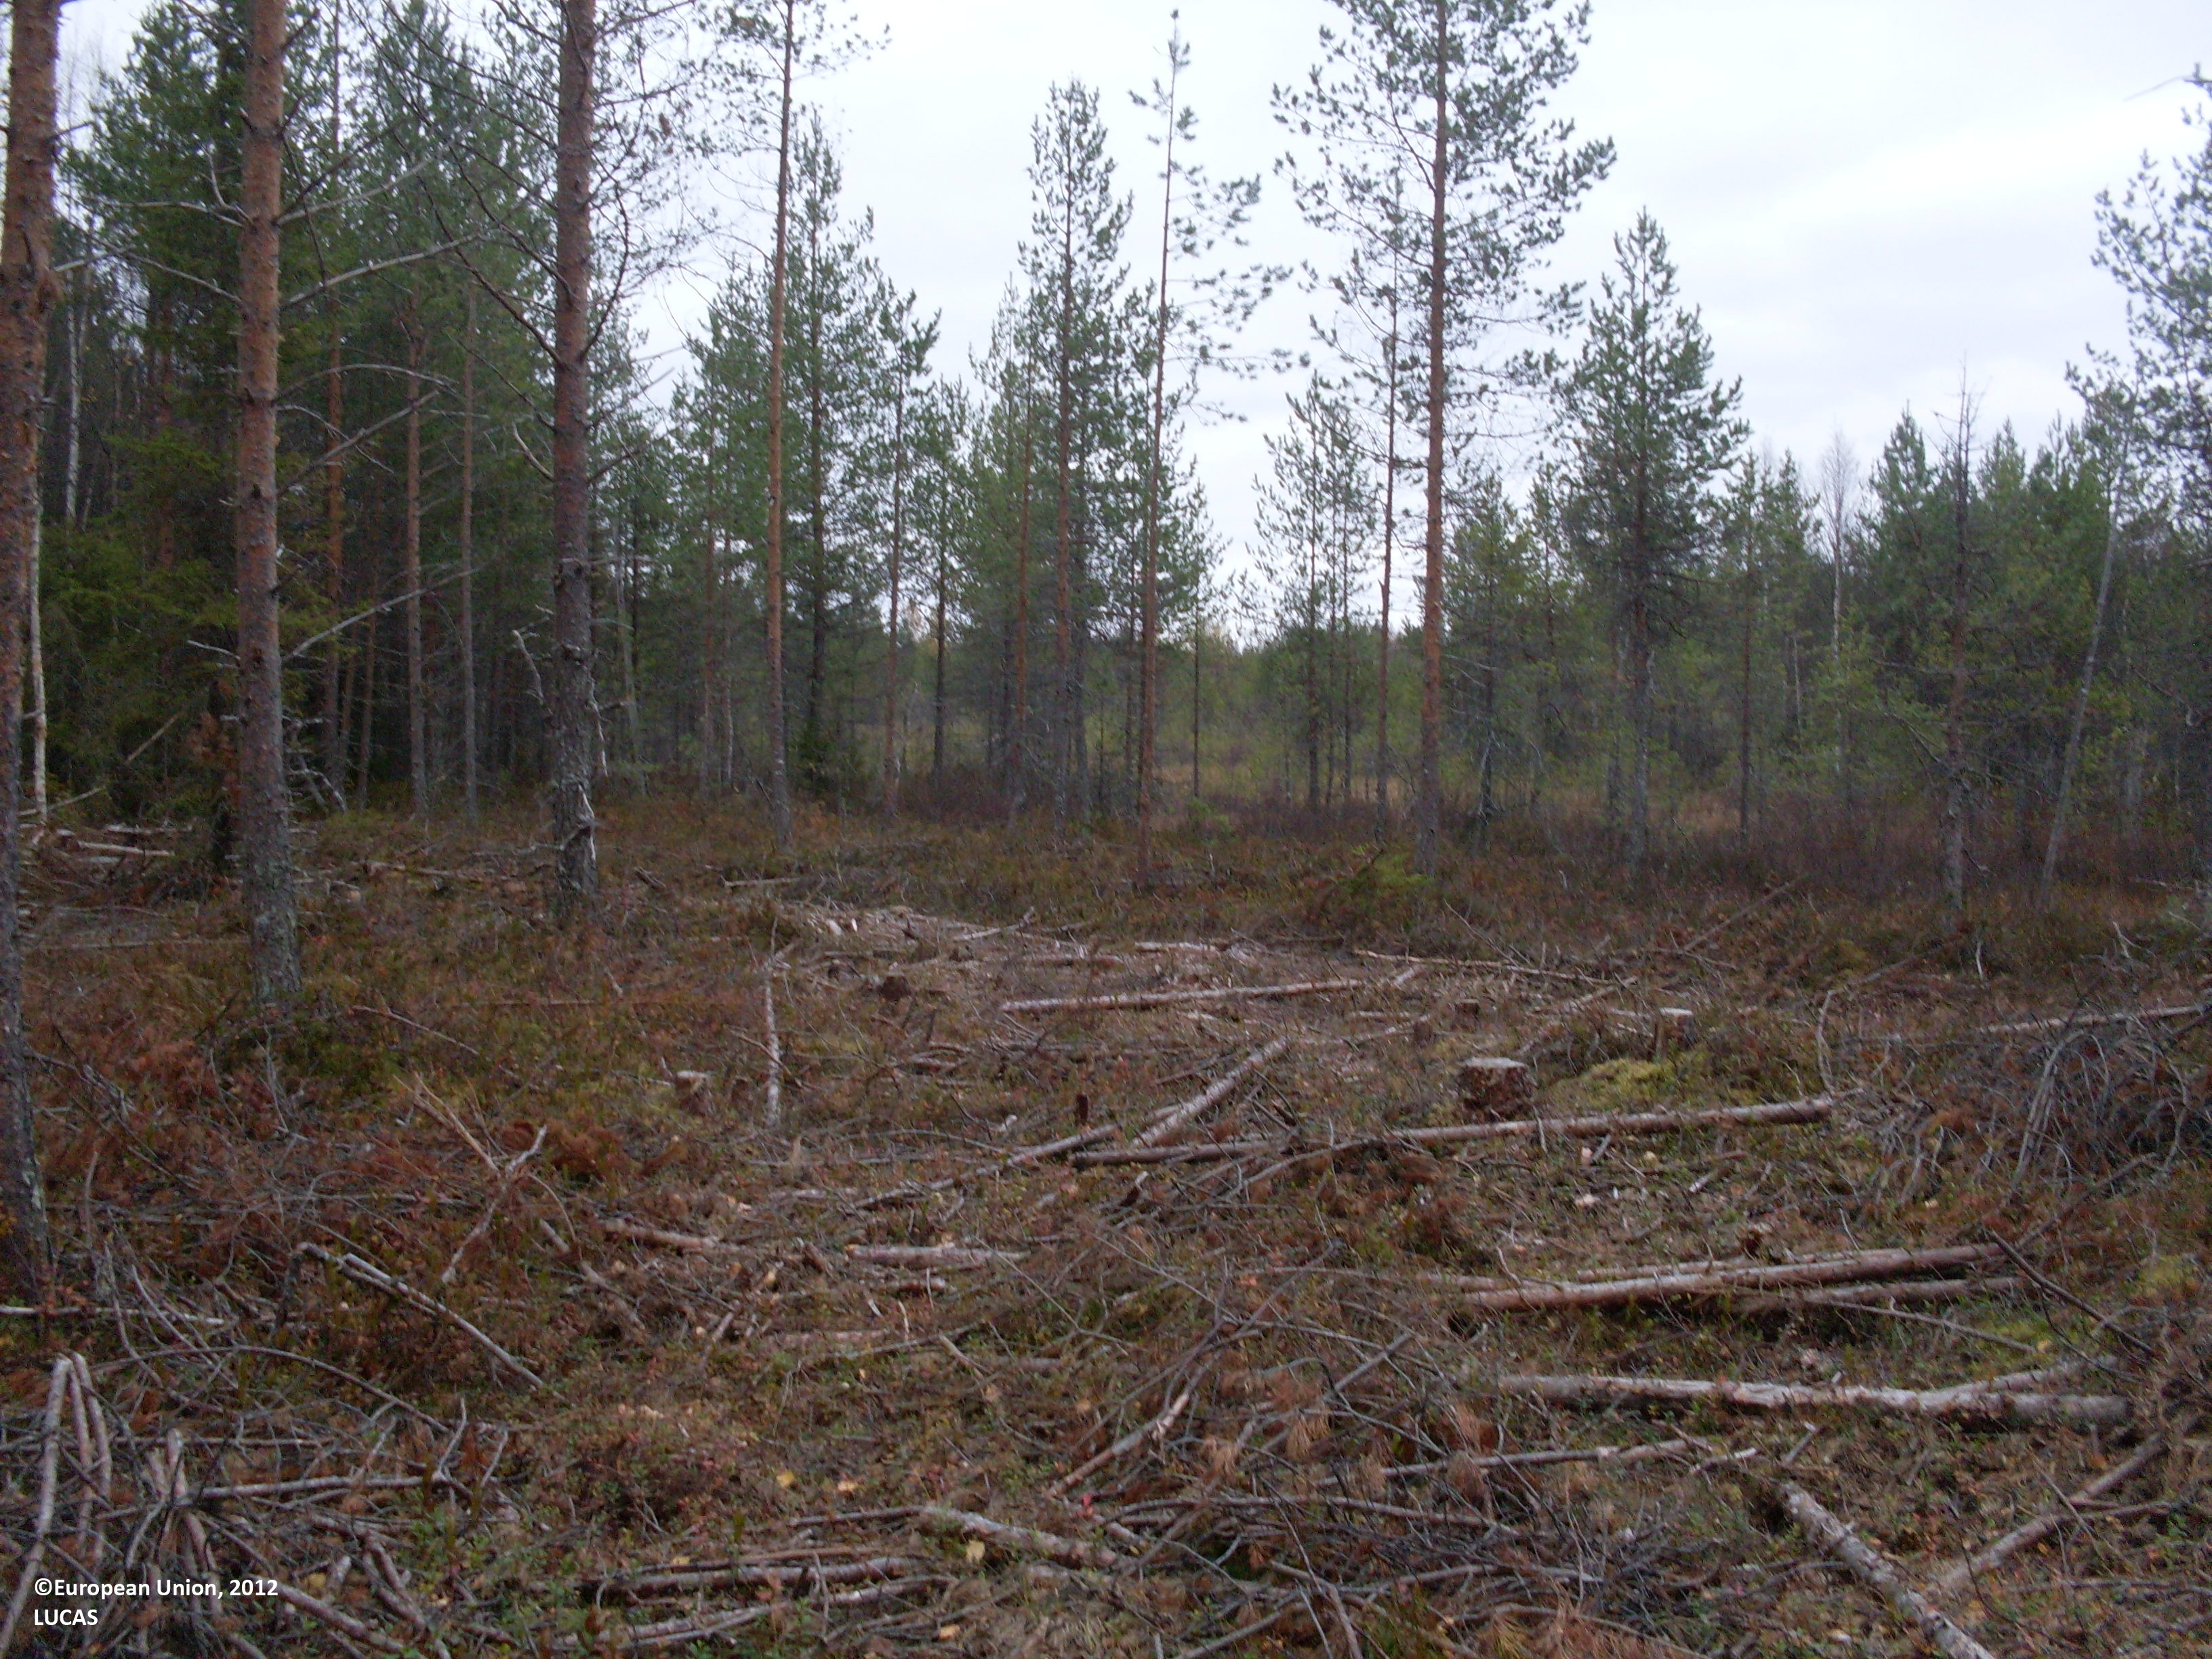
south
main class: Woodland
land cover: Pine dominated mixed woodland
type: boreal forest
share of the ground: 25 - 50 %
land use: Forestry
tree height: > 5 m
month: September
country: FI
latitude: 64.3116
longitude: 29.9386
